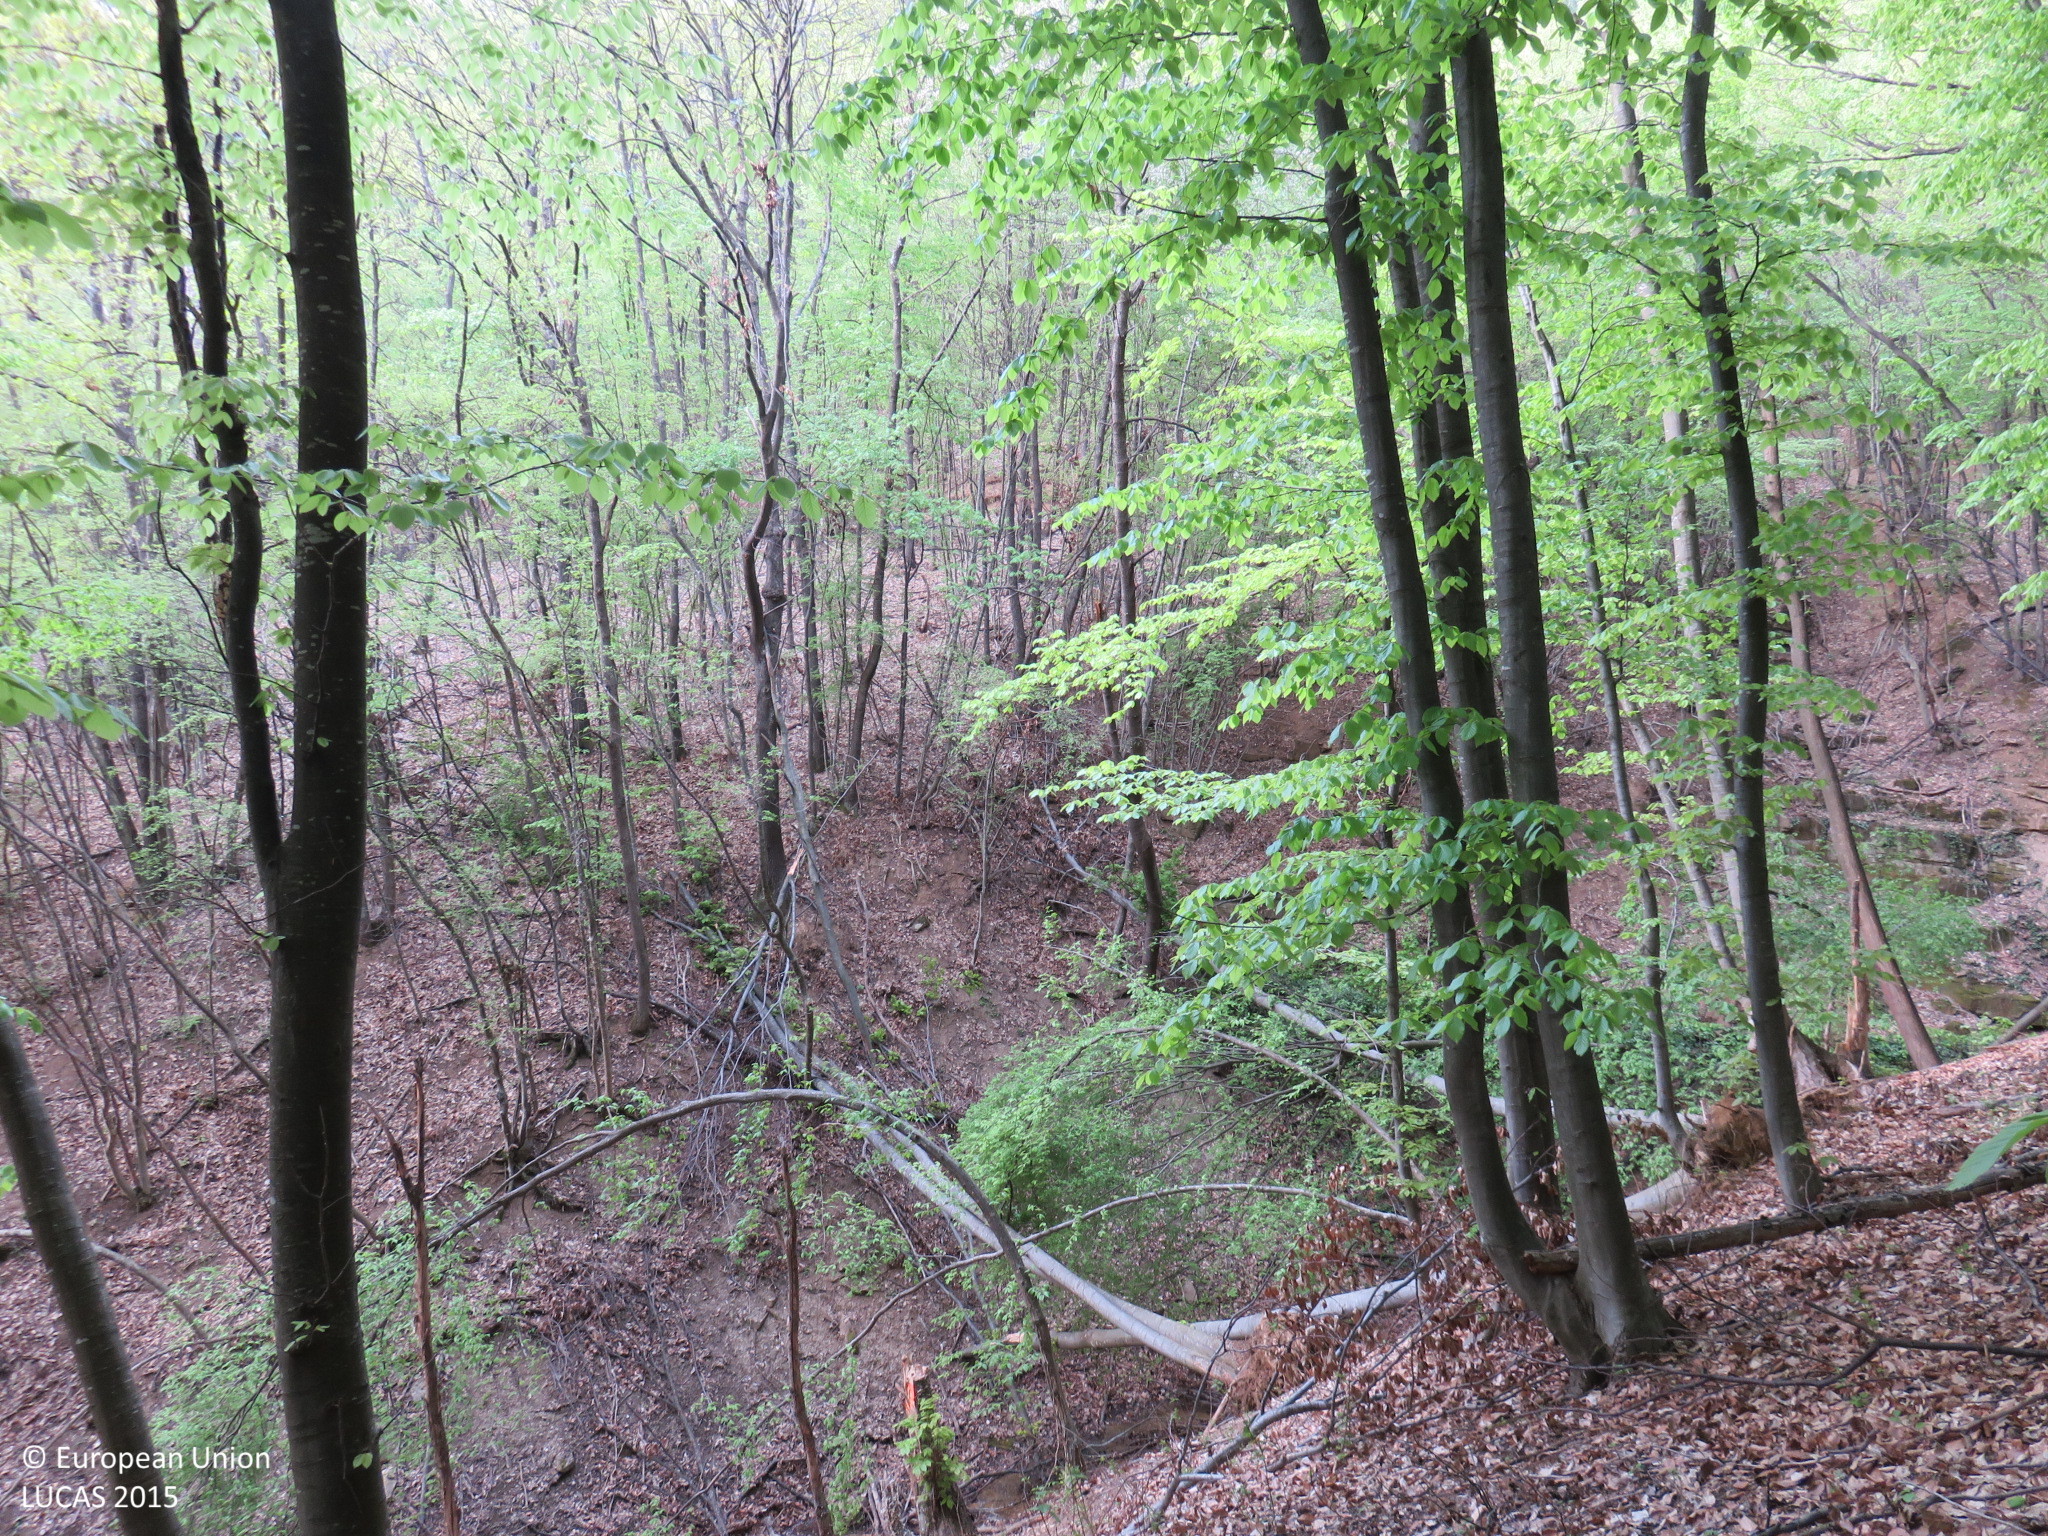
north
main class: Woodland
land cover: Broadleaved woodland
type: beech forest
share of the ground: > 75 %
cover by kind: broadleaved forest trees 80 %, unconsolidated bare surface 20 %
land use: Forestry
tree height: > 5 m
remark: Clear cut
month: April
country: BG
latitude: 43.0187
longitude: 24.8490
